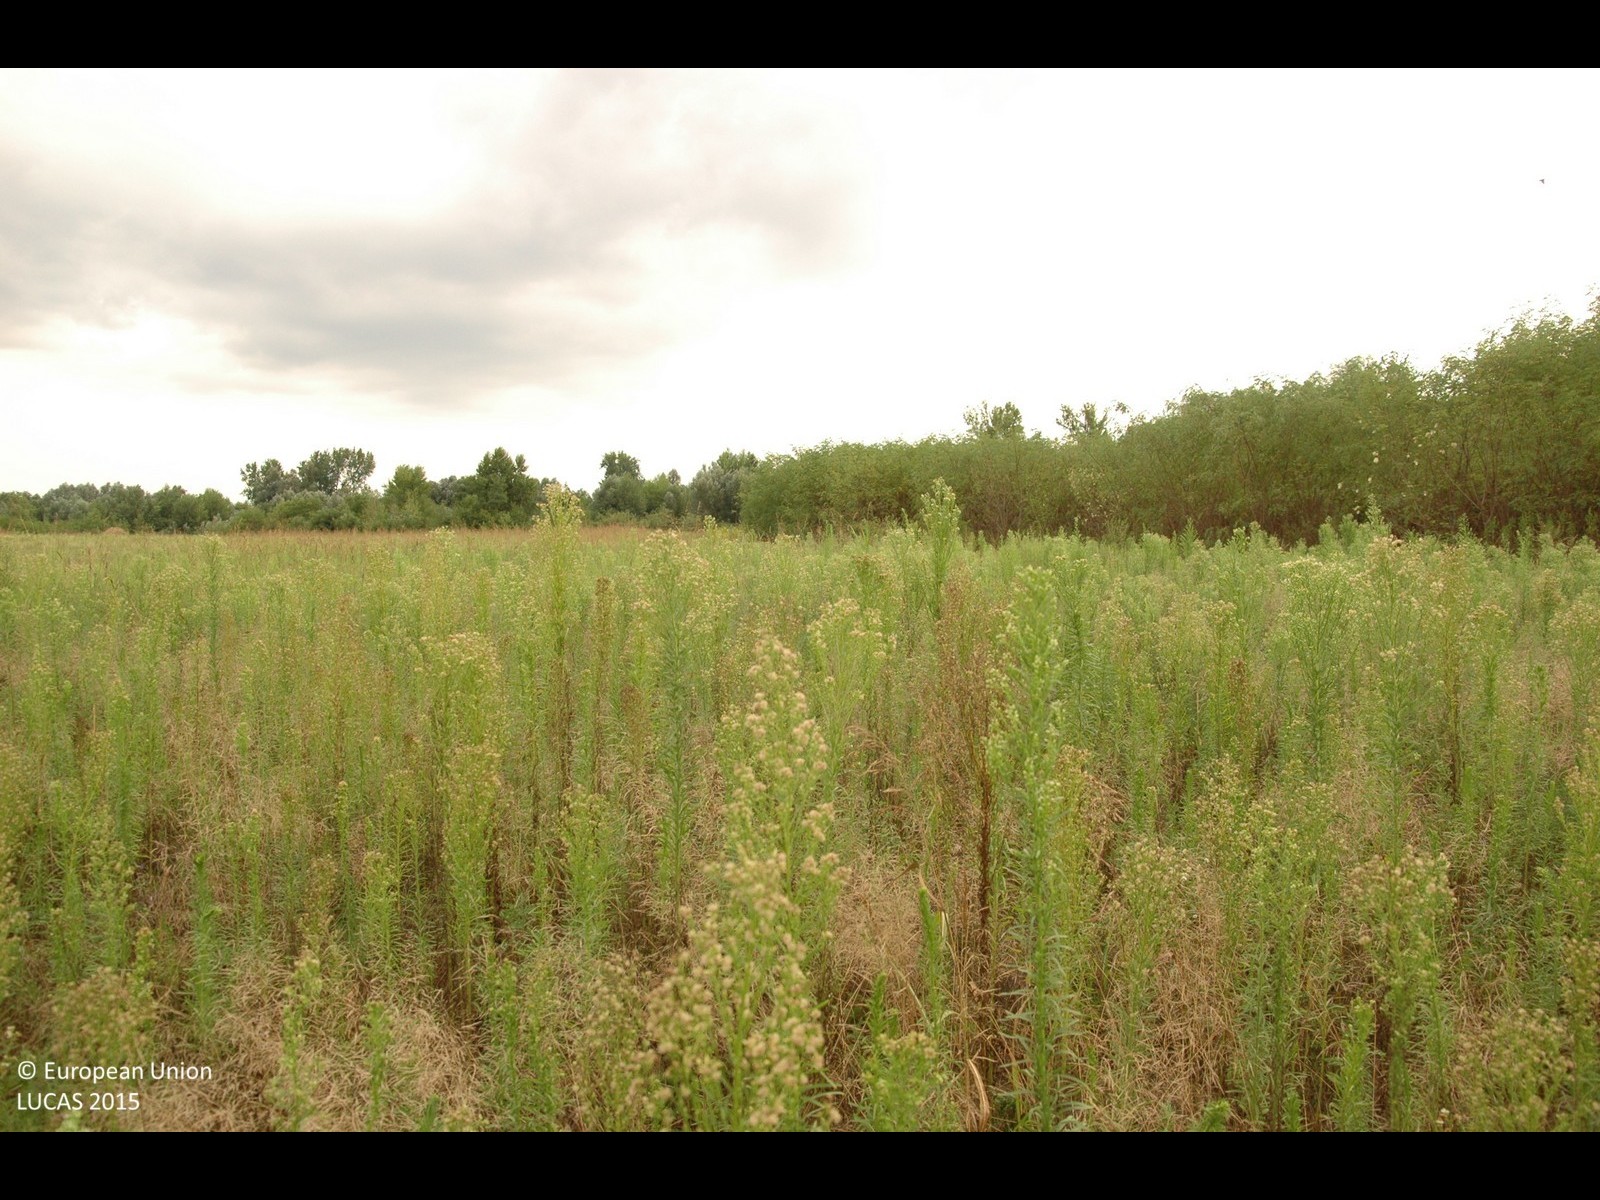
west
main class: Grassland
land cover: Grassland without tree/shrub cover
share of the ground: > 75 %
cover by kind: herbaceous plants 100 %
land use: Agriculture (excluding fallow land and kitchen gardens)
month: August
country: HR
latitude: 46.1983
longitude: 16.9347
